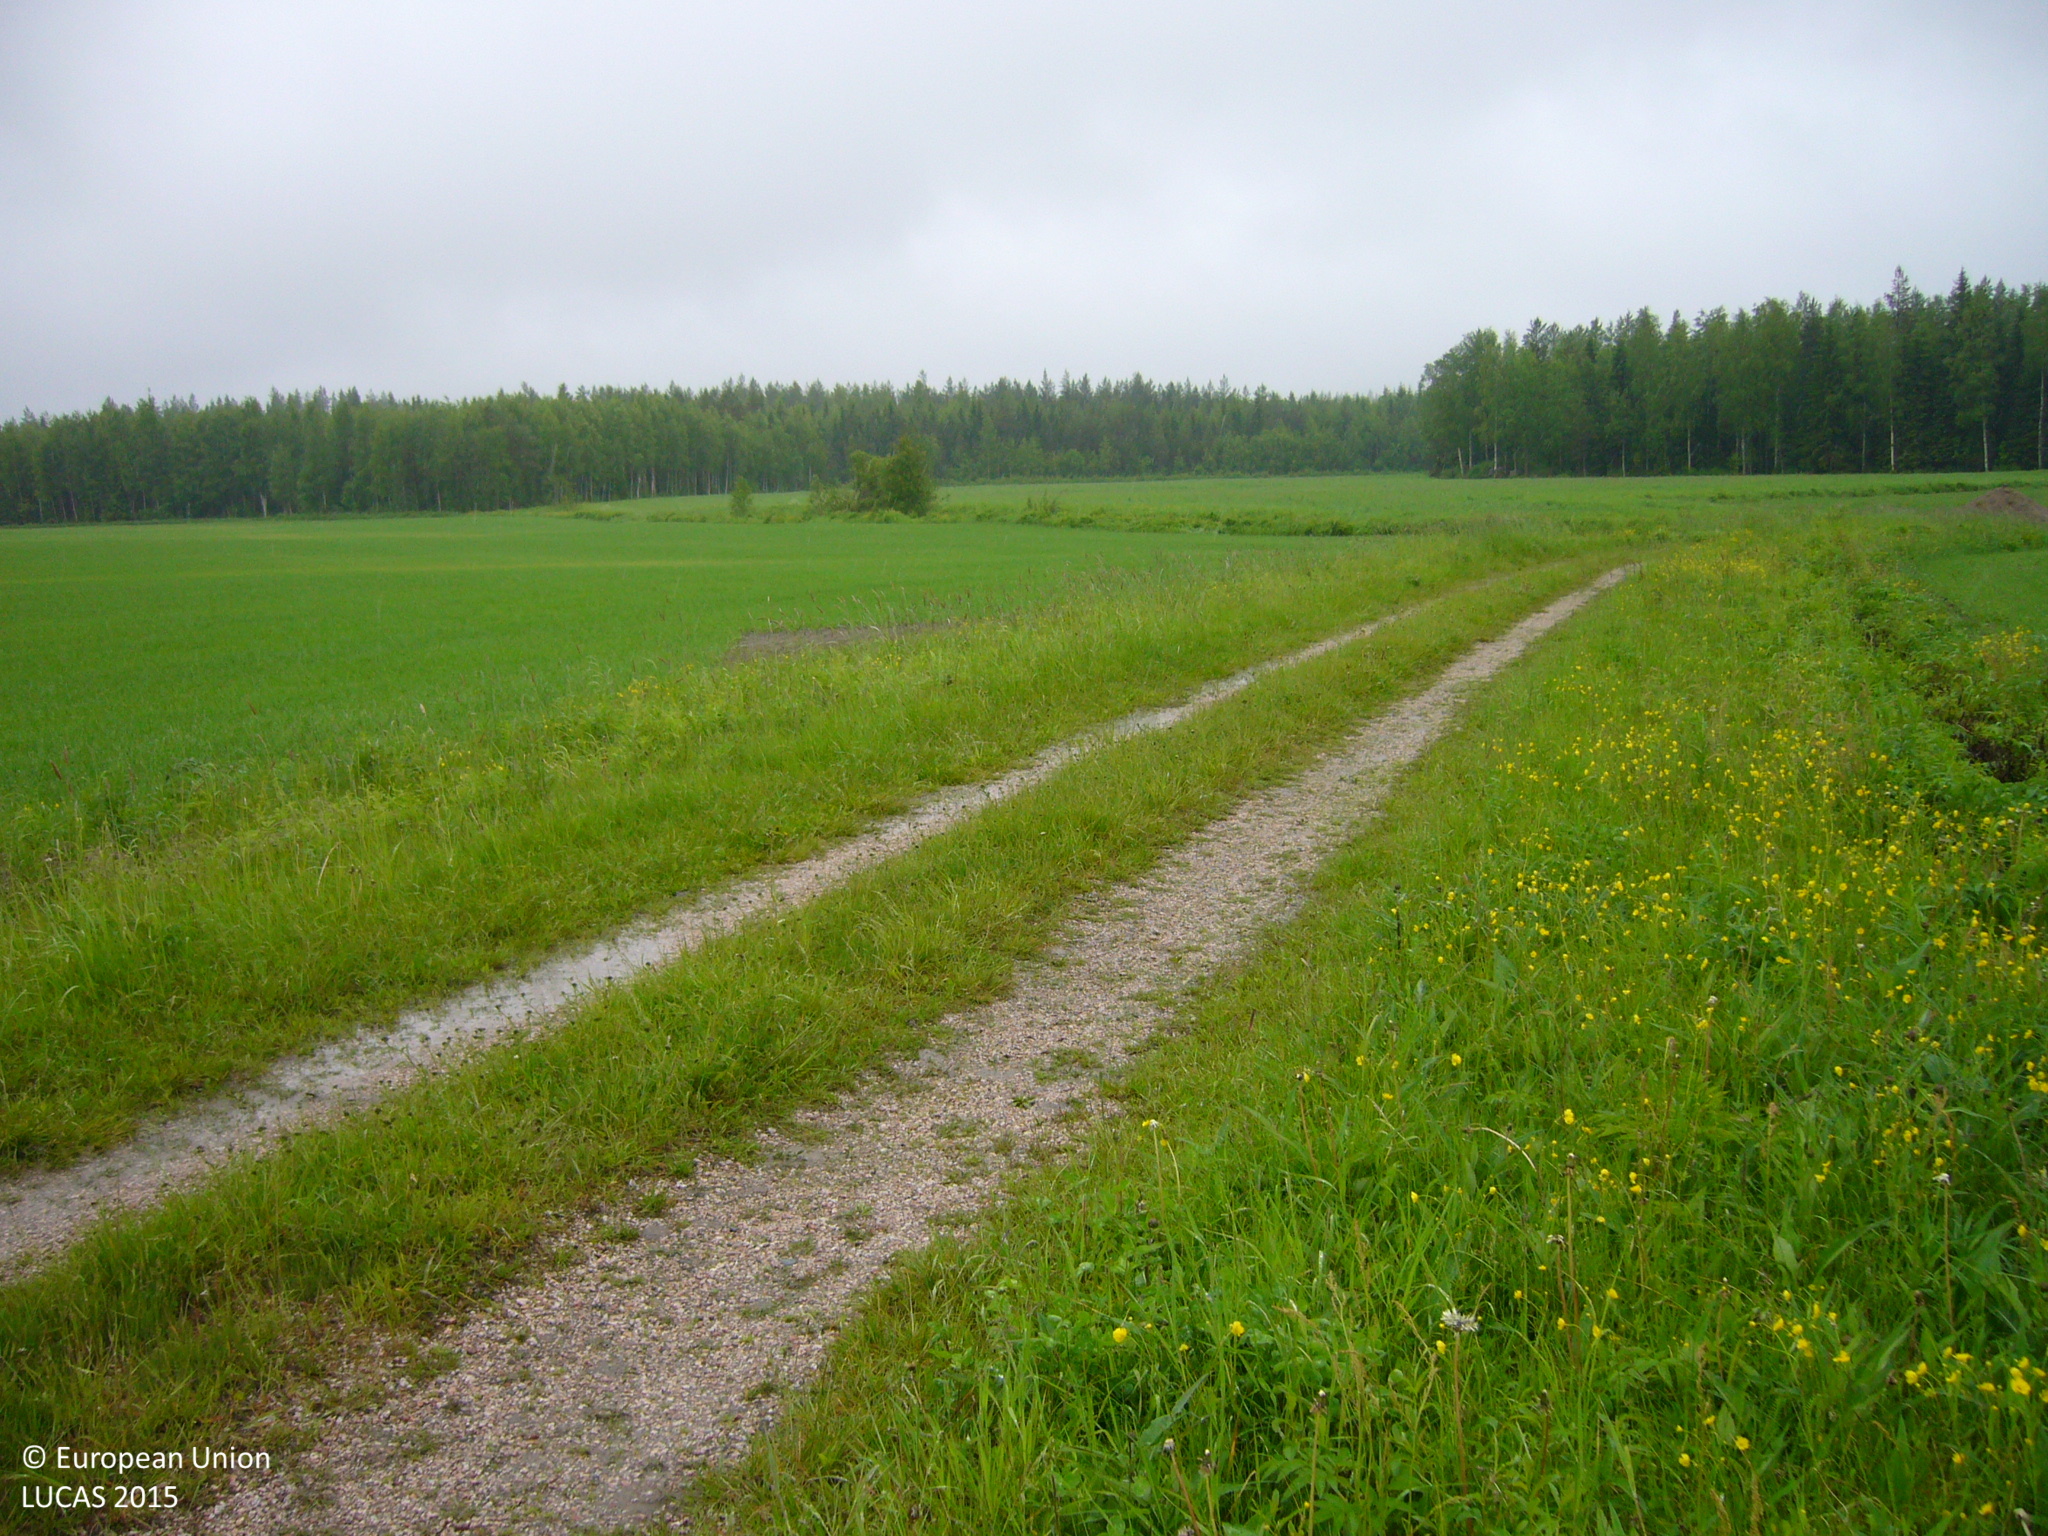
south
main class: Cropland
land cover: Barley
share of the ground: 50 - 75 %
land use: Agriculture (excluding fallow land and kitchen gardens)
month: June
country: FI
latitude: 63.7958
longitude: 25.1306
